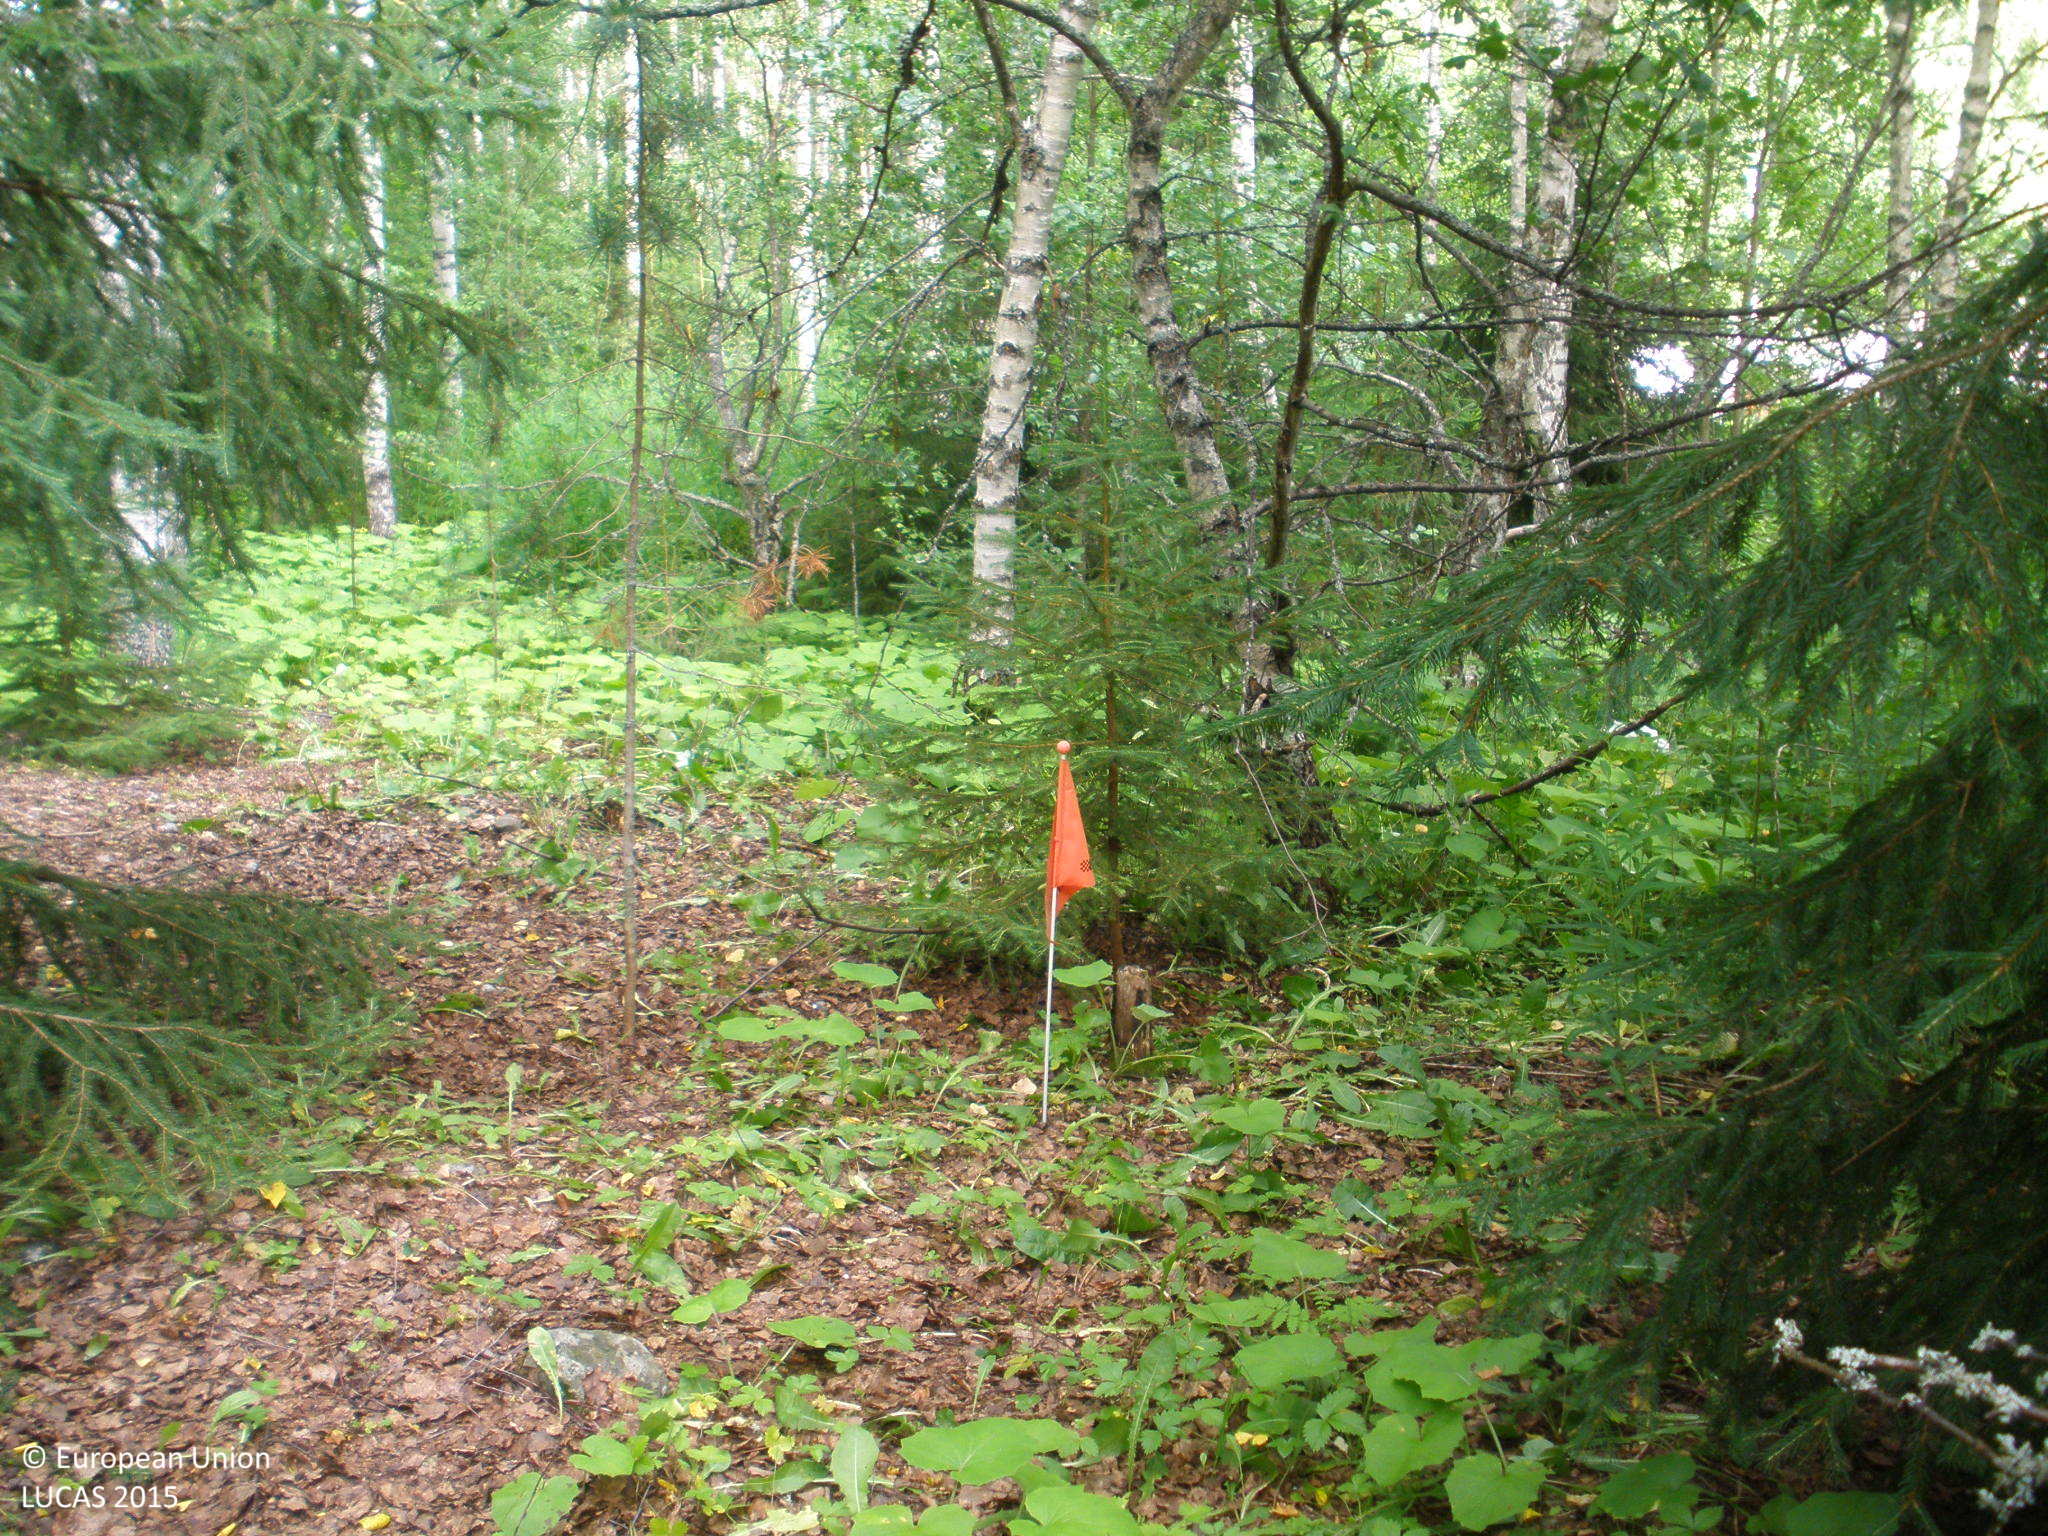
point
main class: Woodland
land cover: Spruce dominated mixed woodland
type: boreal forest
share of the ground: > 75 %
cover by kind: broadleaved forest trees 50 %, coniferous forest trees 25 %, herbaceous plants 20 %, shrubs 5 %
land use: Forestry
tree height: > 5 m
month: July
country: FI
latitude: 60.9520
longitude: 24.1083
